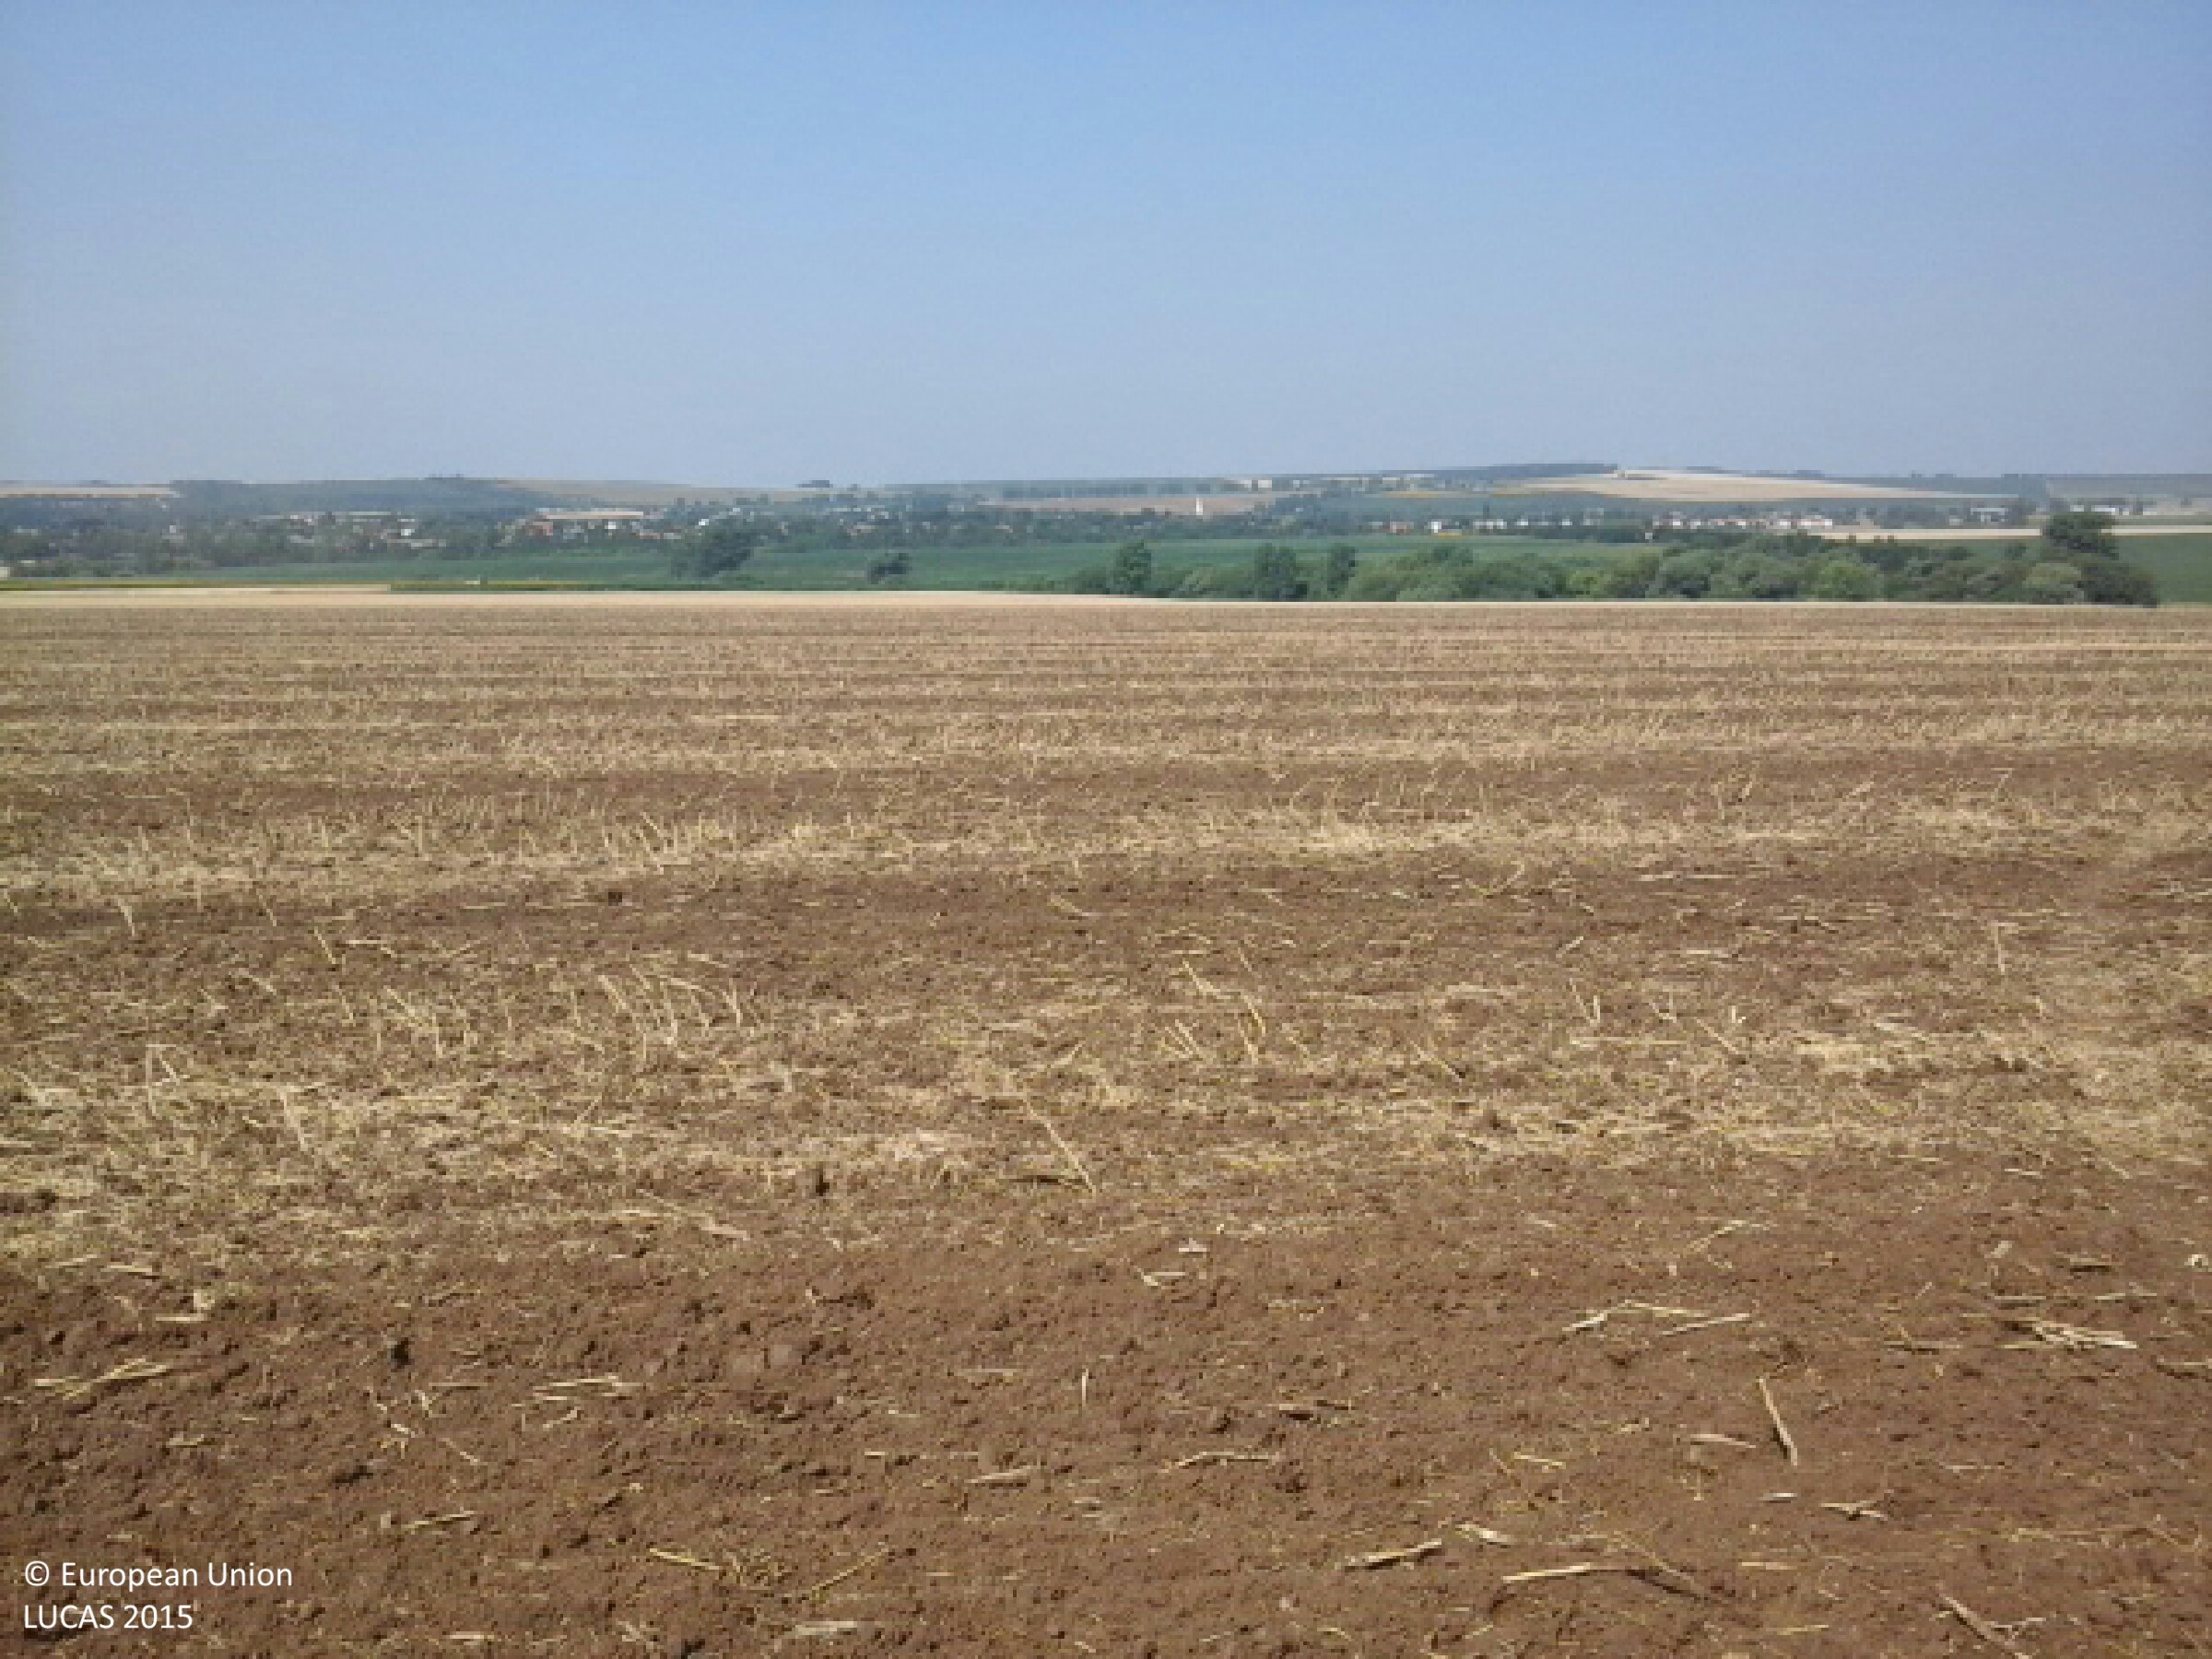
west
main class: Cropland
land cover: Rape and turnip rape
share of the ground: < 10 %
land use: Agriculture (excluding fallow land and kitchen gardens)
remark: Harvested field
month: July
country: HU
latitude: 48.1894
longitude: 21.0845
